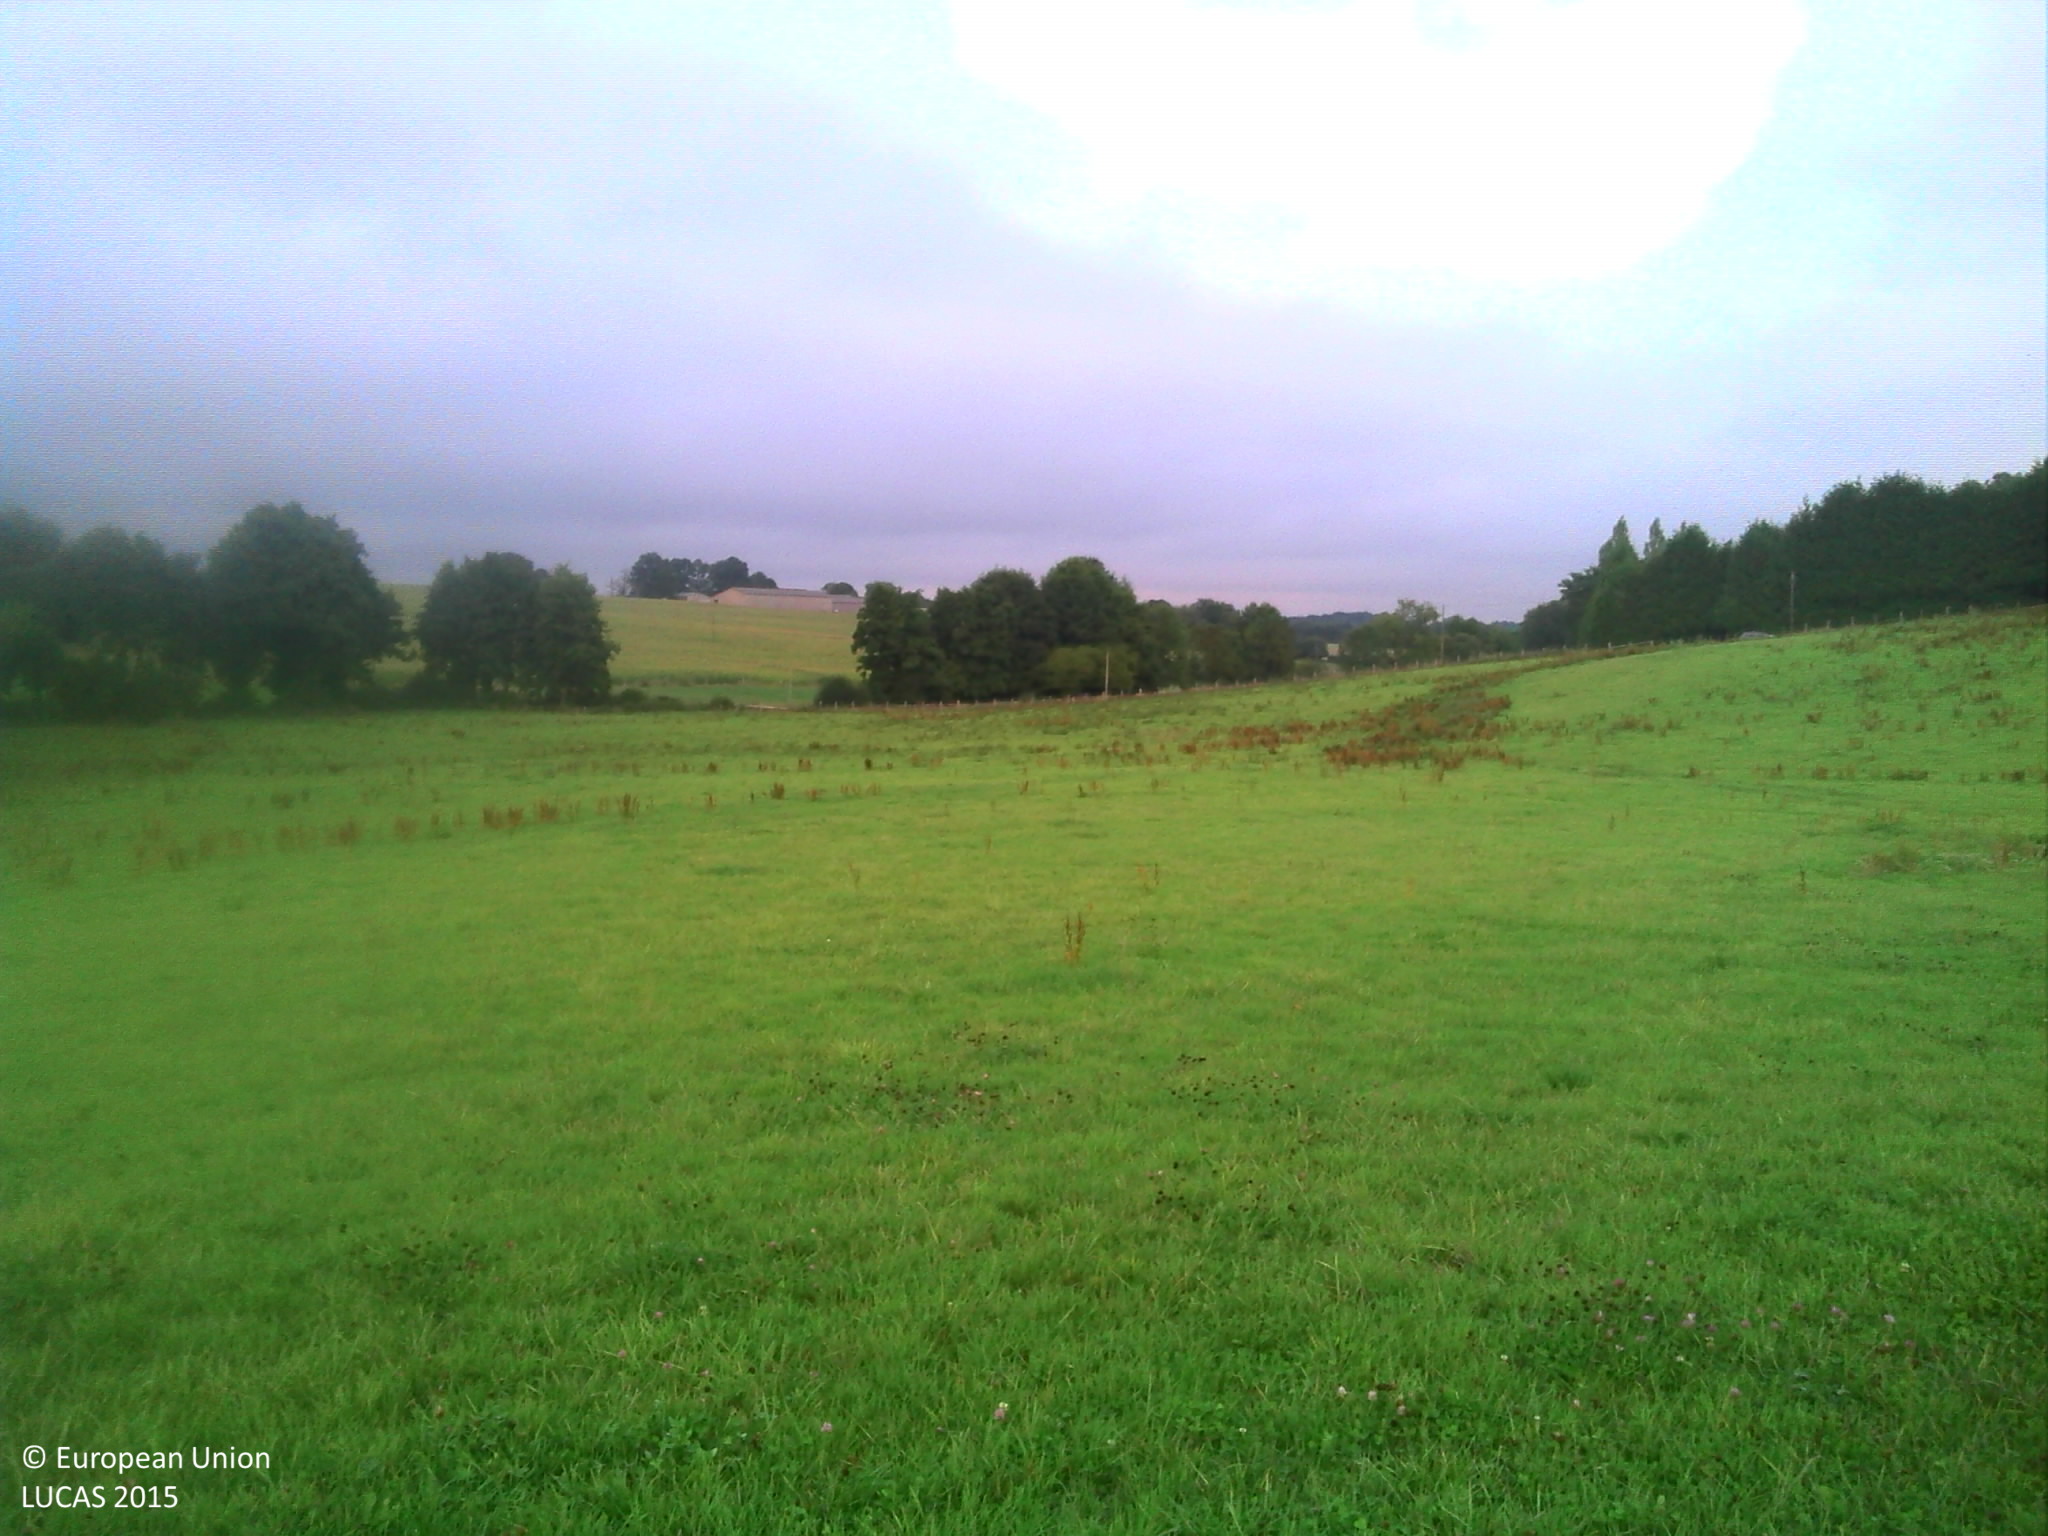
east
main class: Cropland
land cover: Maize
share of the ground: > 75 %
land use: Agriculture (excluding fallow land and kitchen gardens)
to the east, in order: Maize; Grassland without tree/shrub cover; Fences; Electric lines; Tracks; Conifer hedges
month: August
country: FR
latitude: 48.4642
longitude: 0.4948
